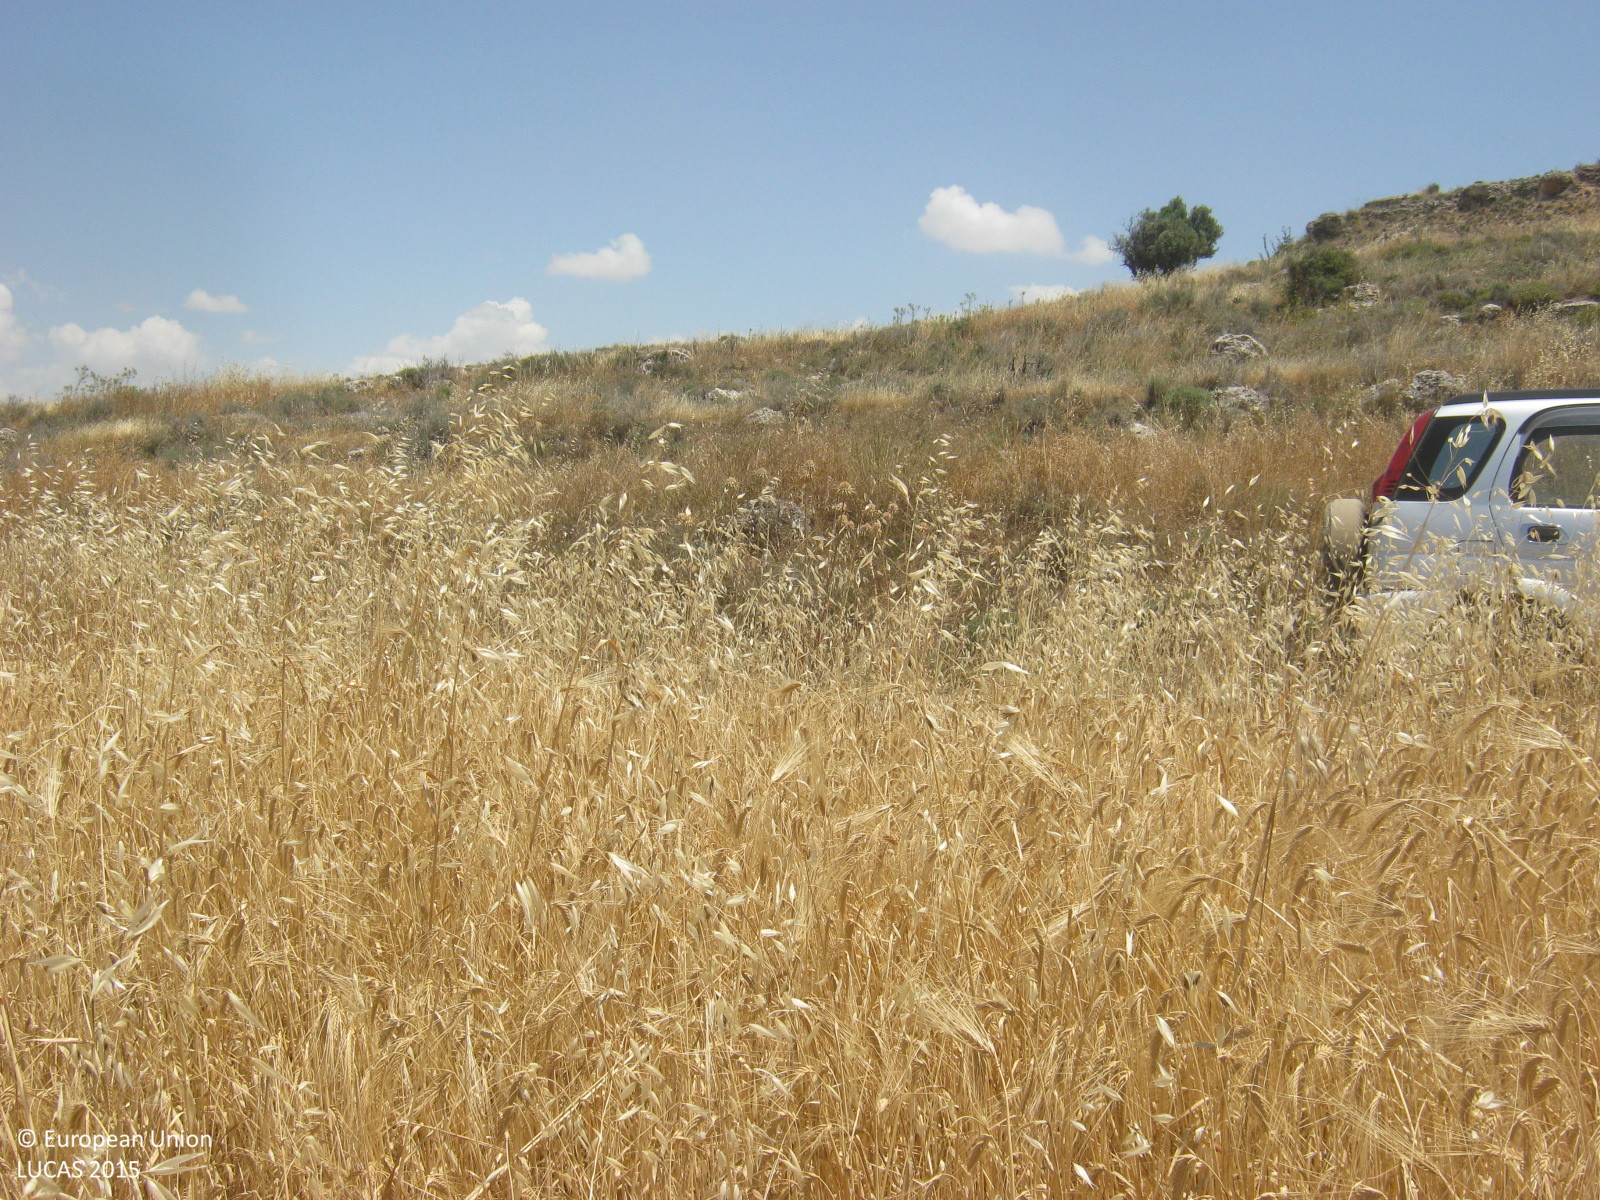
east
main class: Cropland
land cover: Mixed cereals for fodder
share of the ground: > 75 %
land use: Agriculture (excluding fallow land and kitchen gardens)
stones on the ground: < 10 %
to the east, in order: Mixed cereals for fodder; Paved roads, cycling and walking lanes; Shrubland with sparse tree cover; Other bare soil; Shrubland without tree cover
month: May
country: CY
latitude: 35.0660
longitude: 33.1094
